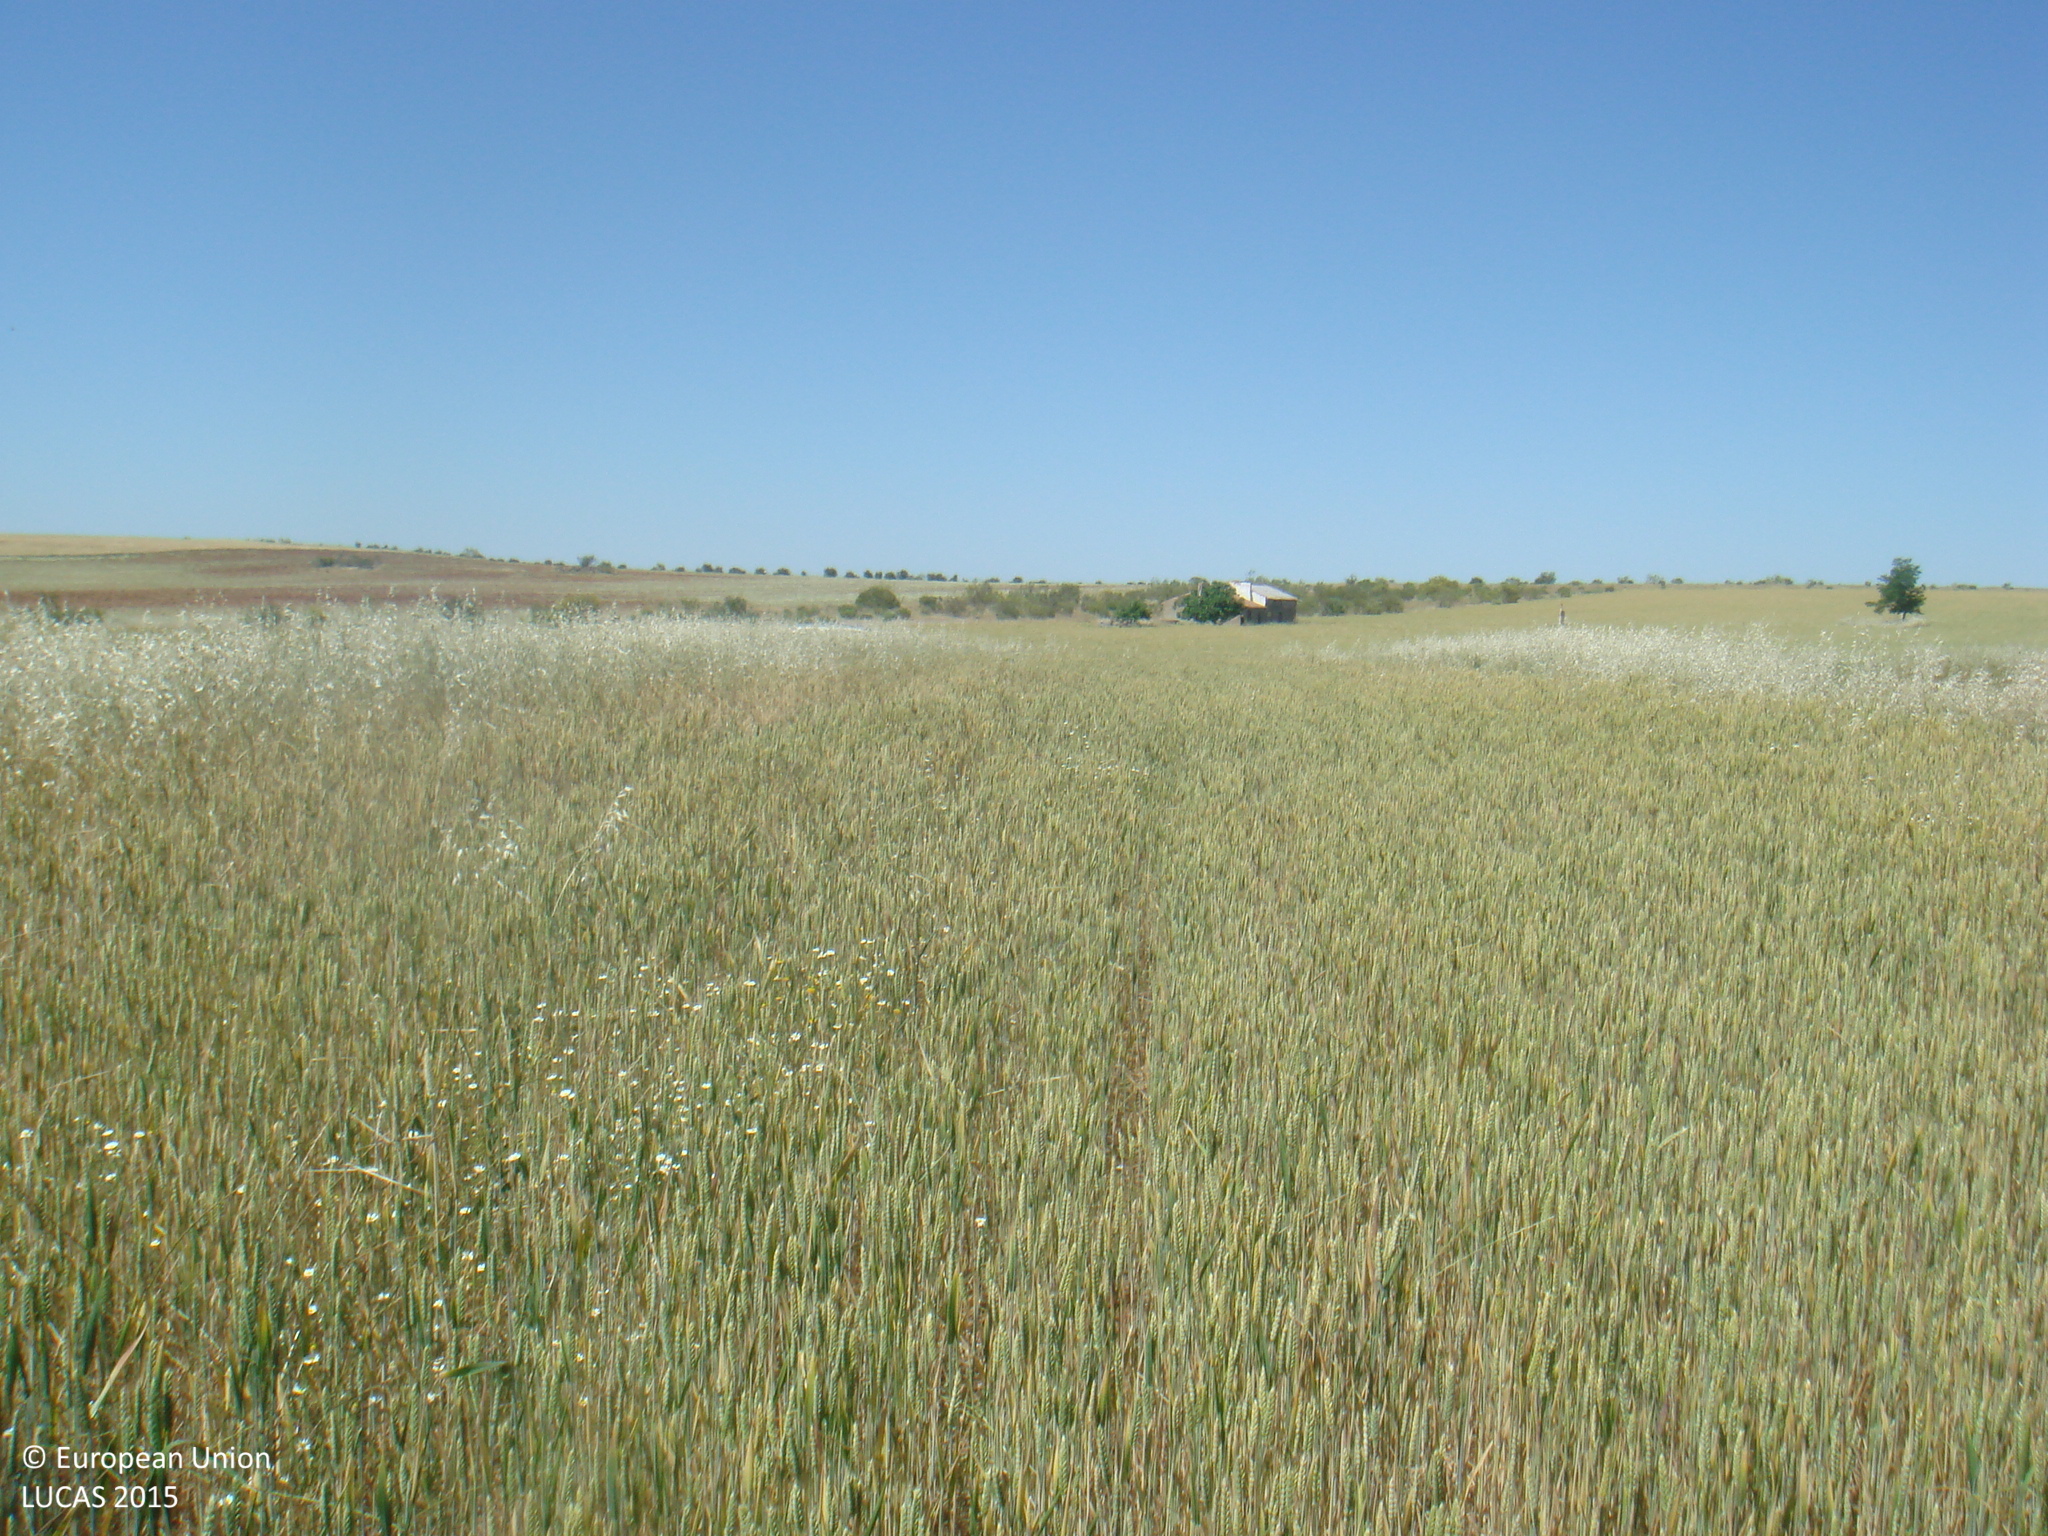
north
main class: Cropland
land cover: Common wheat
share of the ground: > 75 %
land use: Agriculture (excluding fallow land and kitchen gardens)
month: May
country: ES
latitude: 38.5585
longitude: -5.0976
